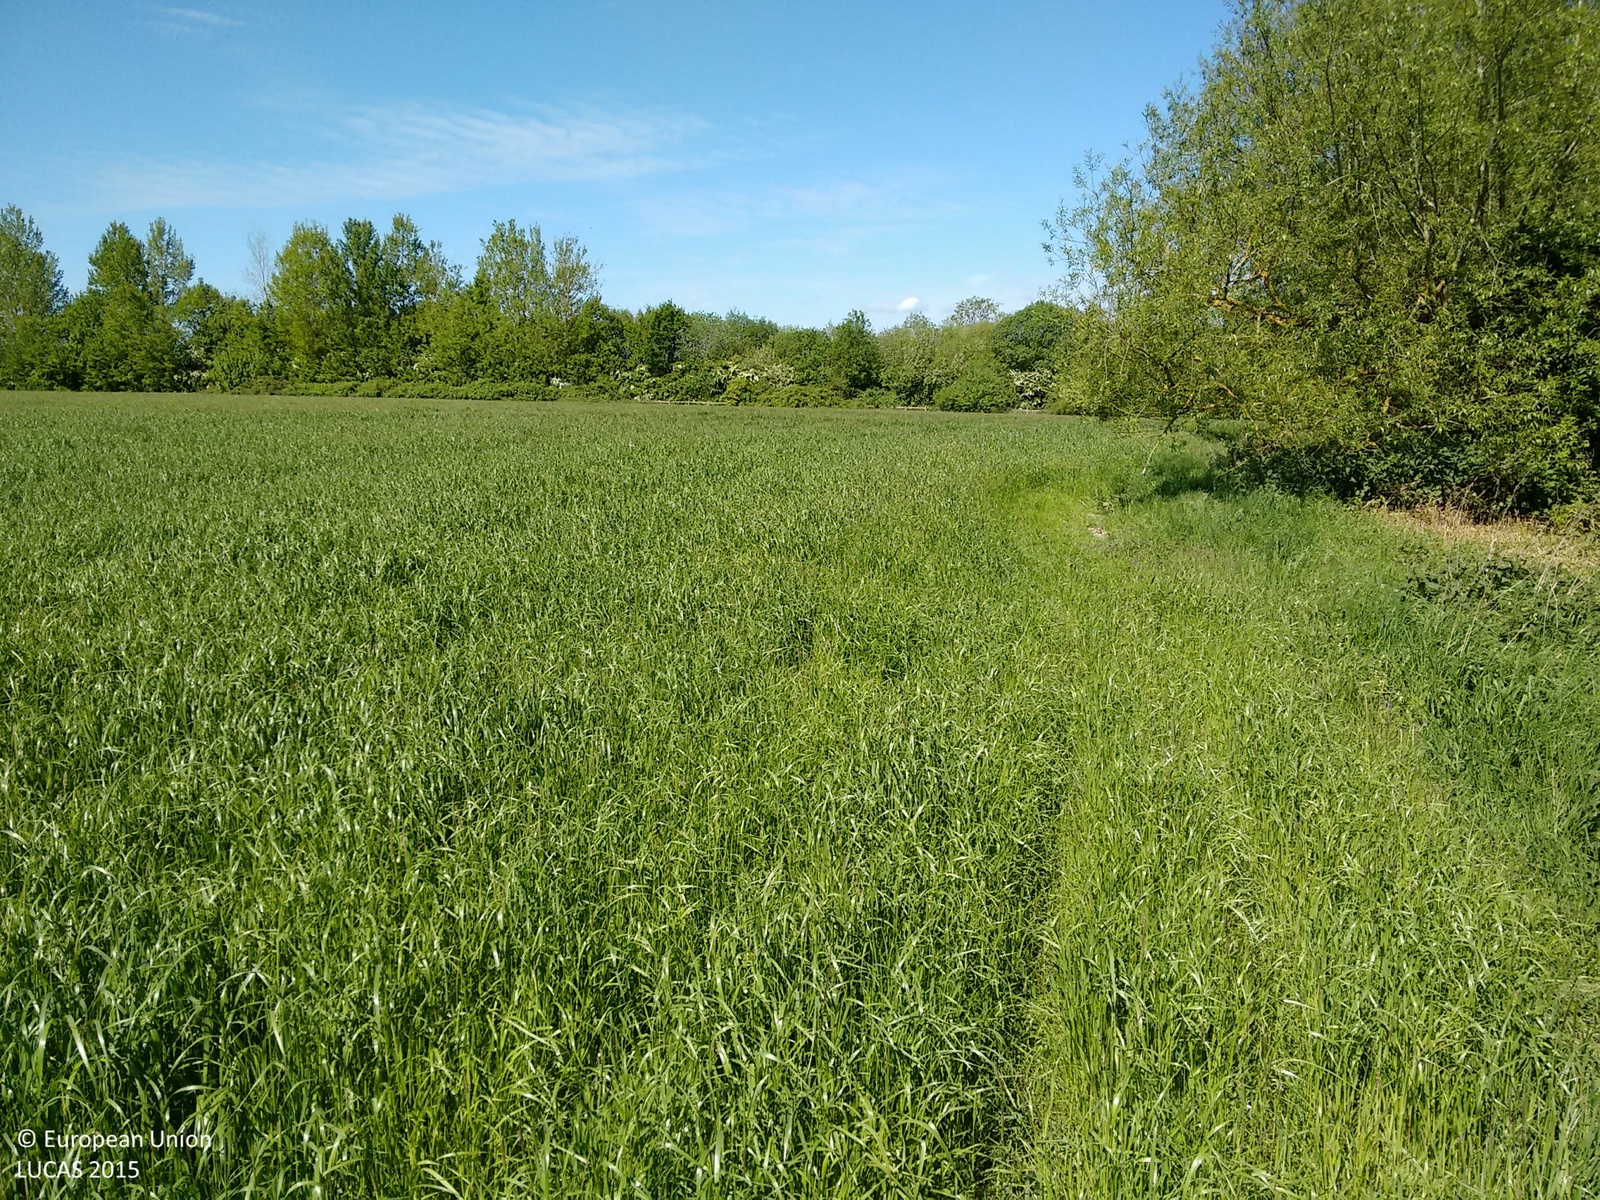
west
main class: Cropland
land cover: Barley
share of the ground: > 75 %
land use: Agriculture (excluding fallow land and kitchen gardens)
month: May
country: GB
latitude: 51.3180
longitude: -1.0212
